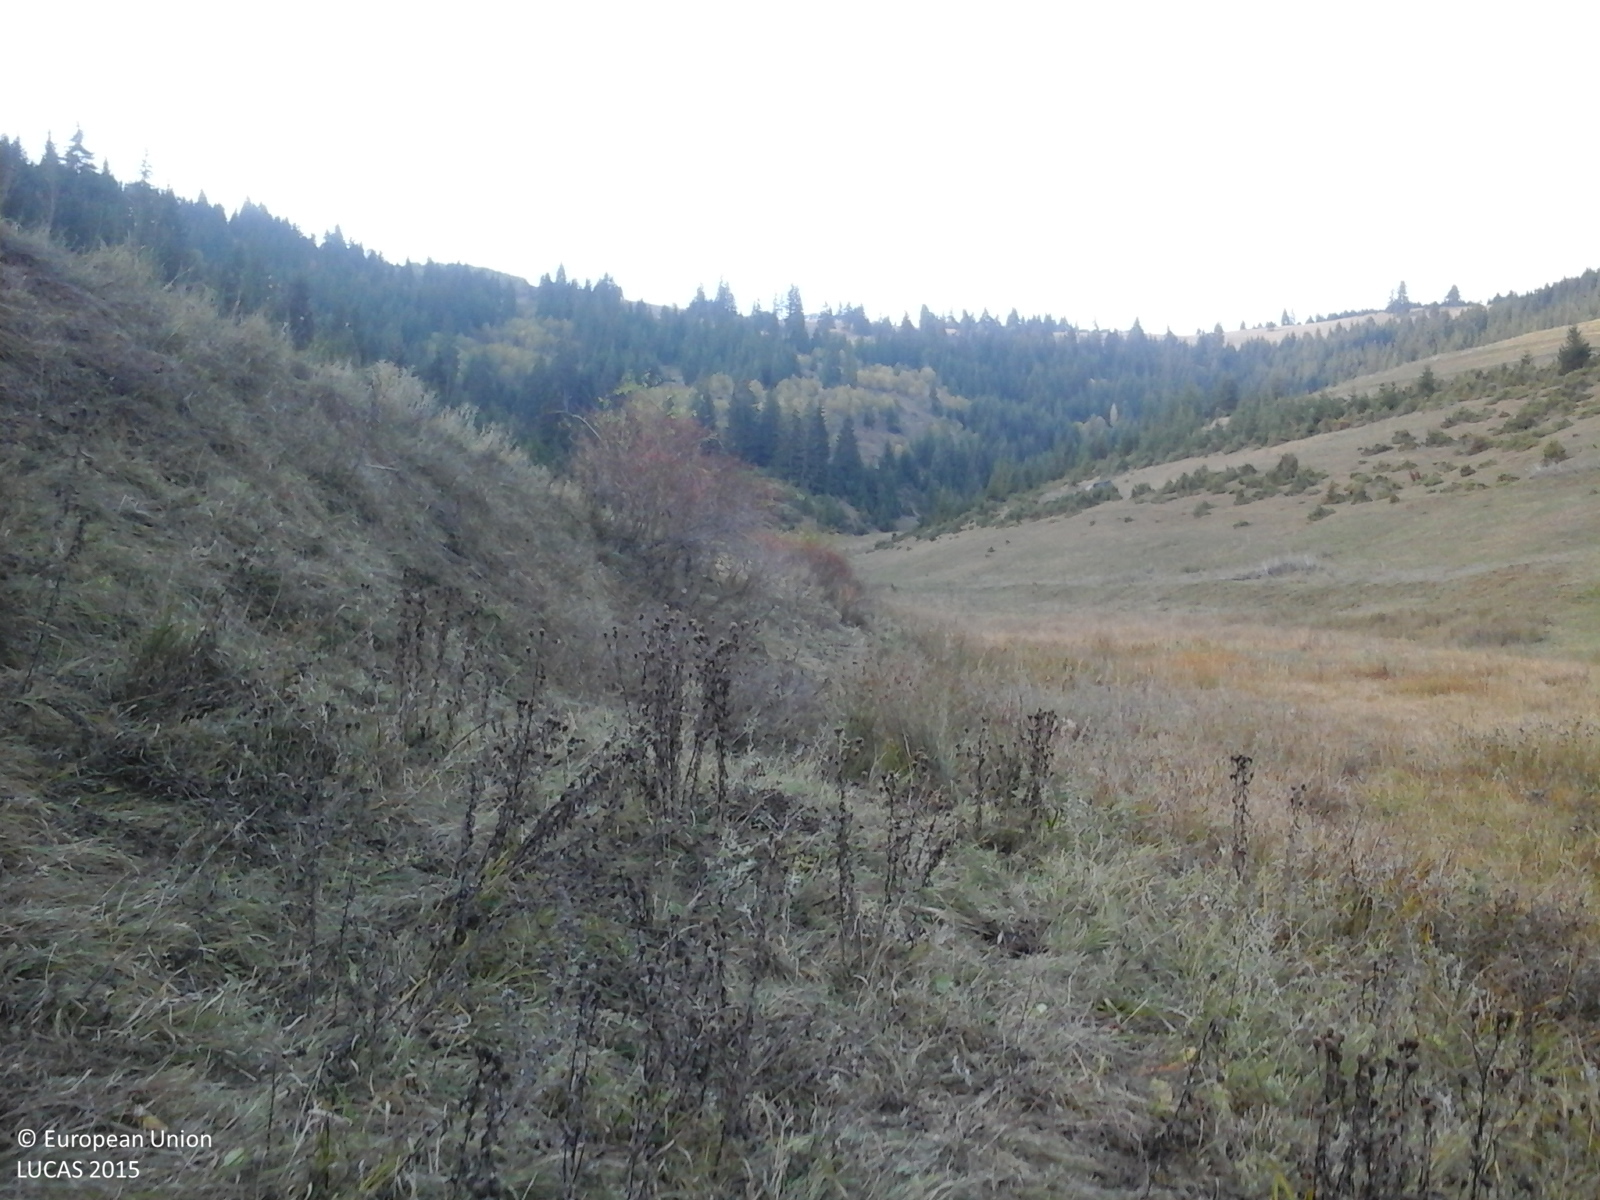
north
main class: Grassland
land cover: Spontaneously vegetated surfaces
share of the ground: > 75 %
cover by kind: herbaceous plants 100 %
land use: Fallow land
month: October
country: RO
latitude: 46.3927
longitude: 25.9456
